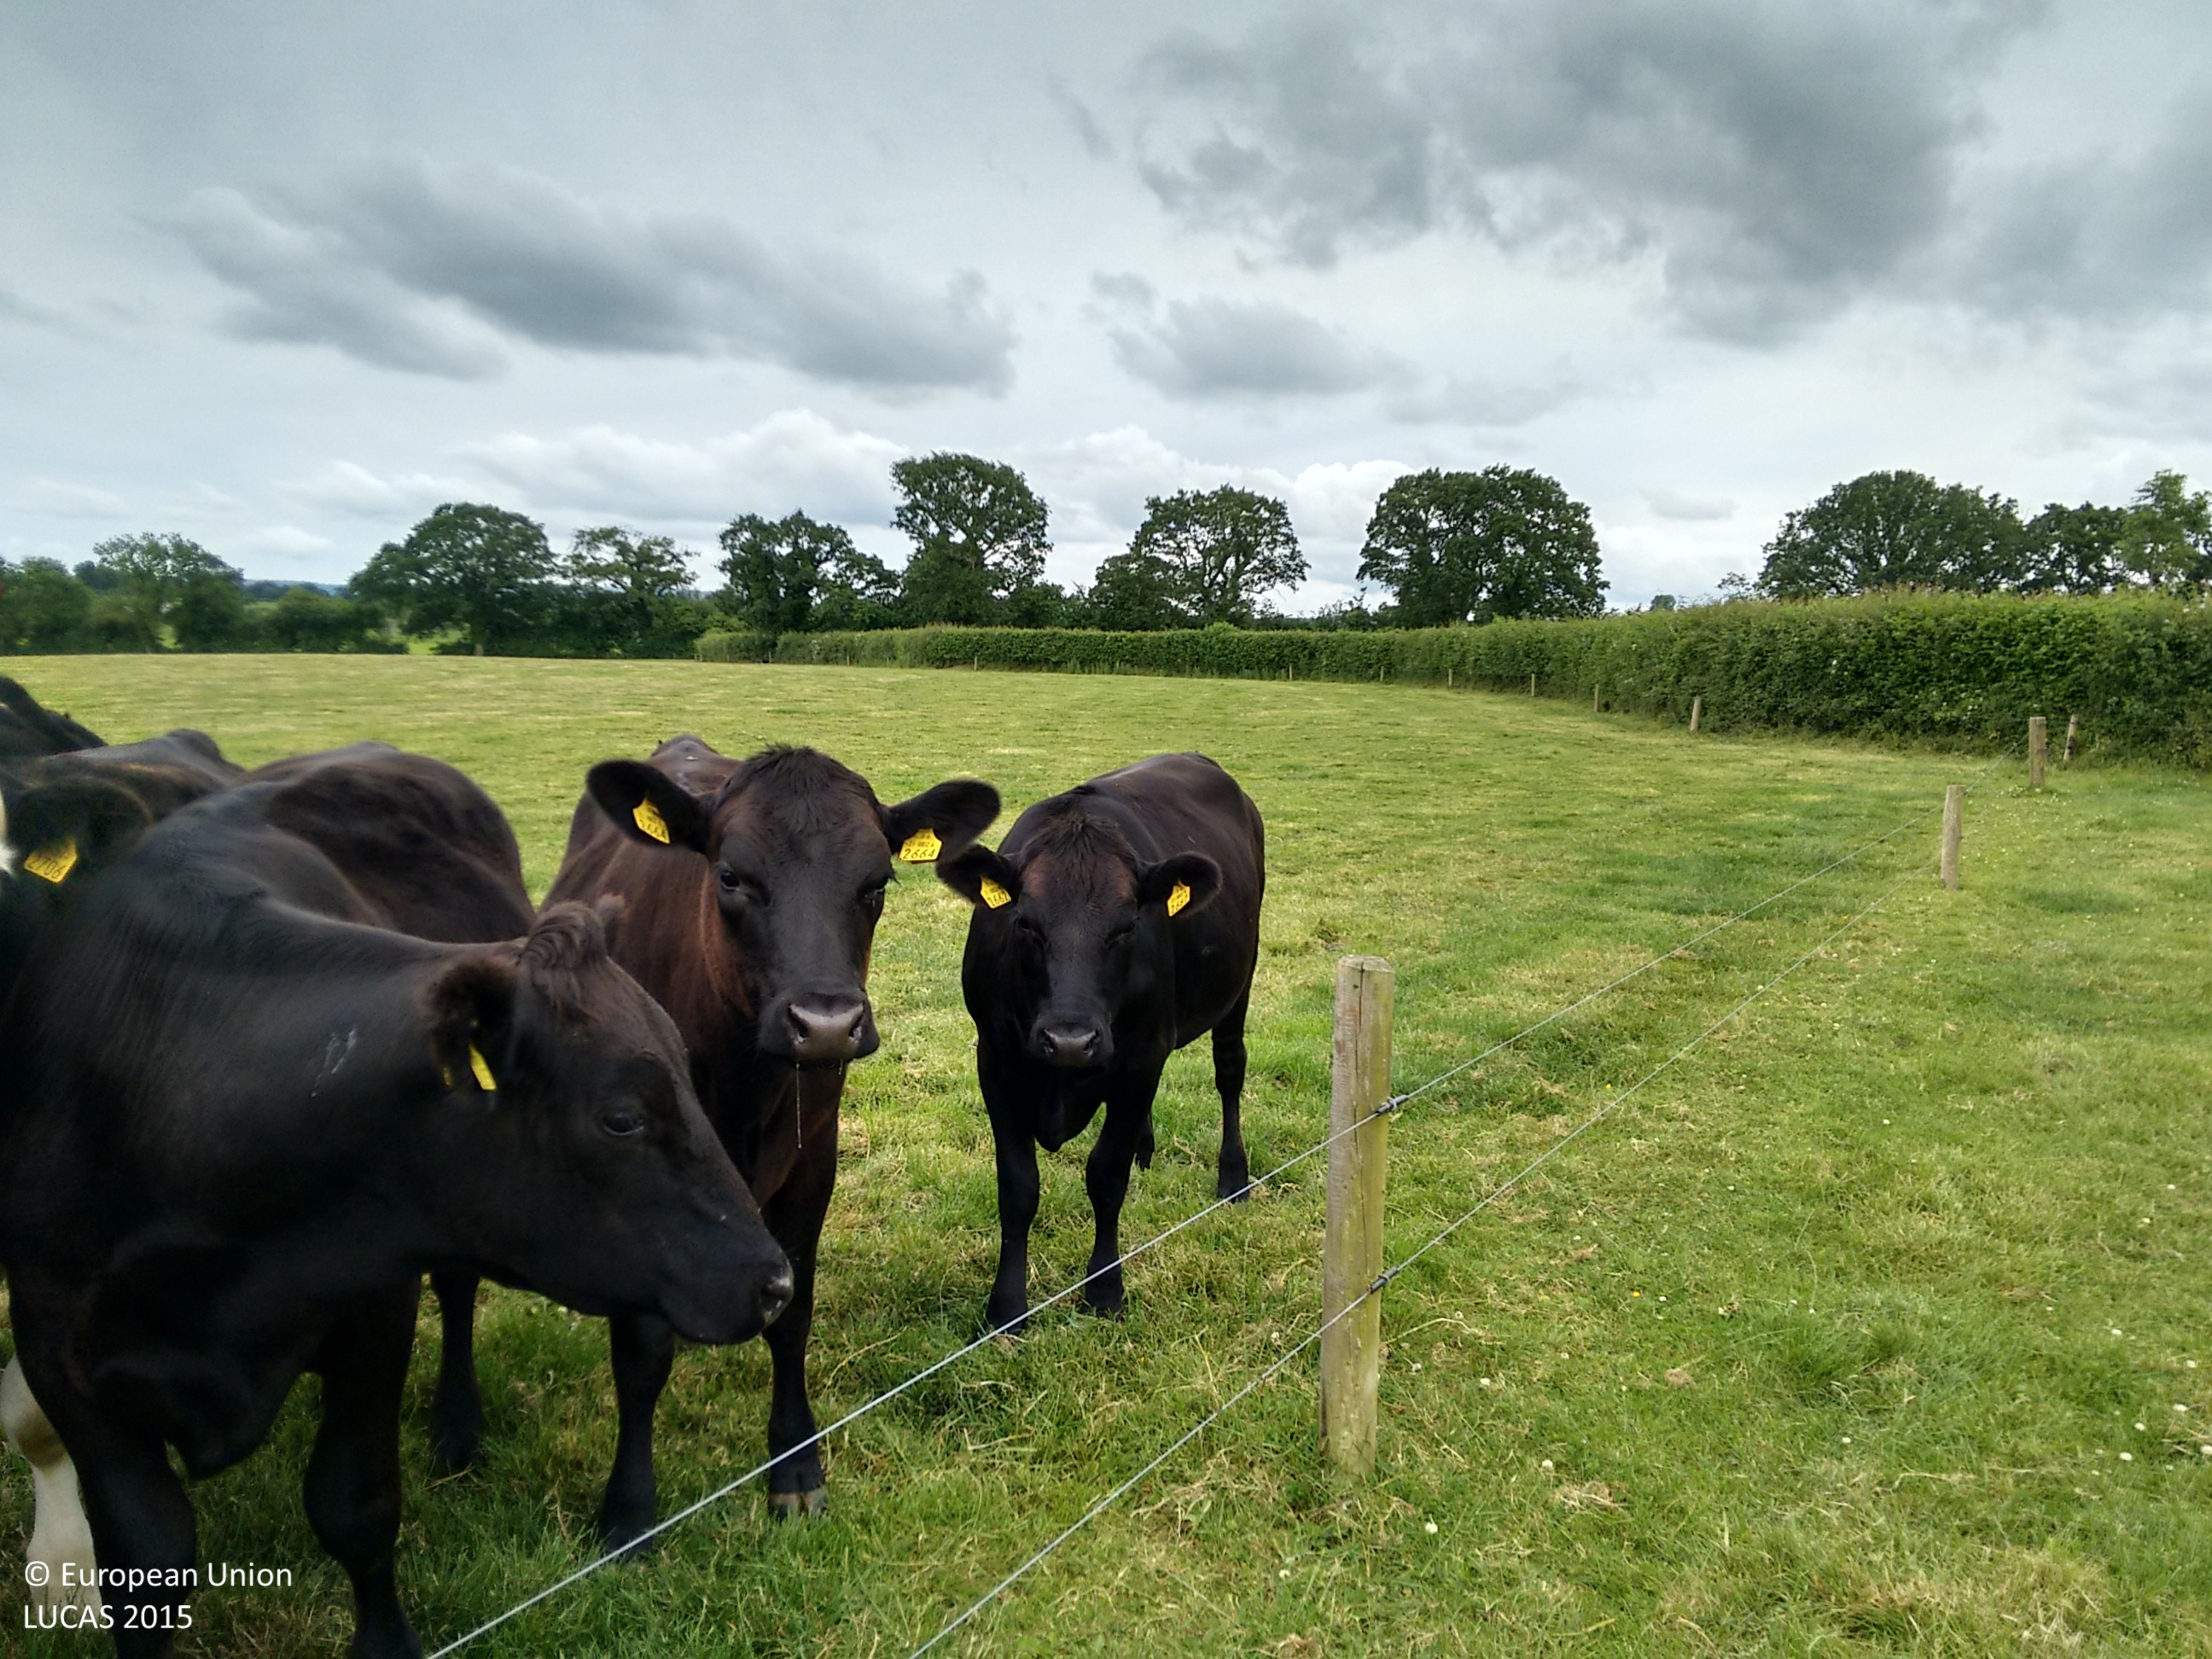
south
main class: Grassland
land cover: Grassland without tree/shrub cover
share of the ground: > 75 %
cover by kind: herbaceous plants 100 %
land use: Agriculture (excluding fallow land and kitchen gardens)
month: July
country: IE
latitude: 52.5387
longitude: -7.3603
